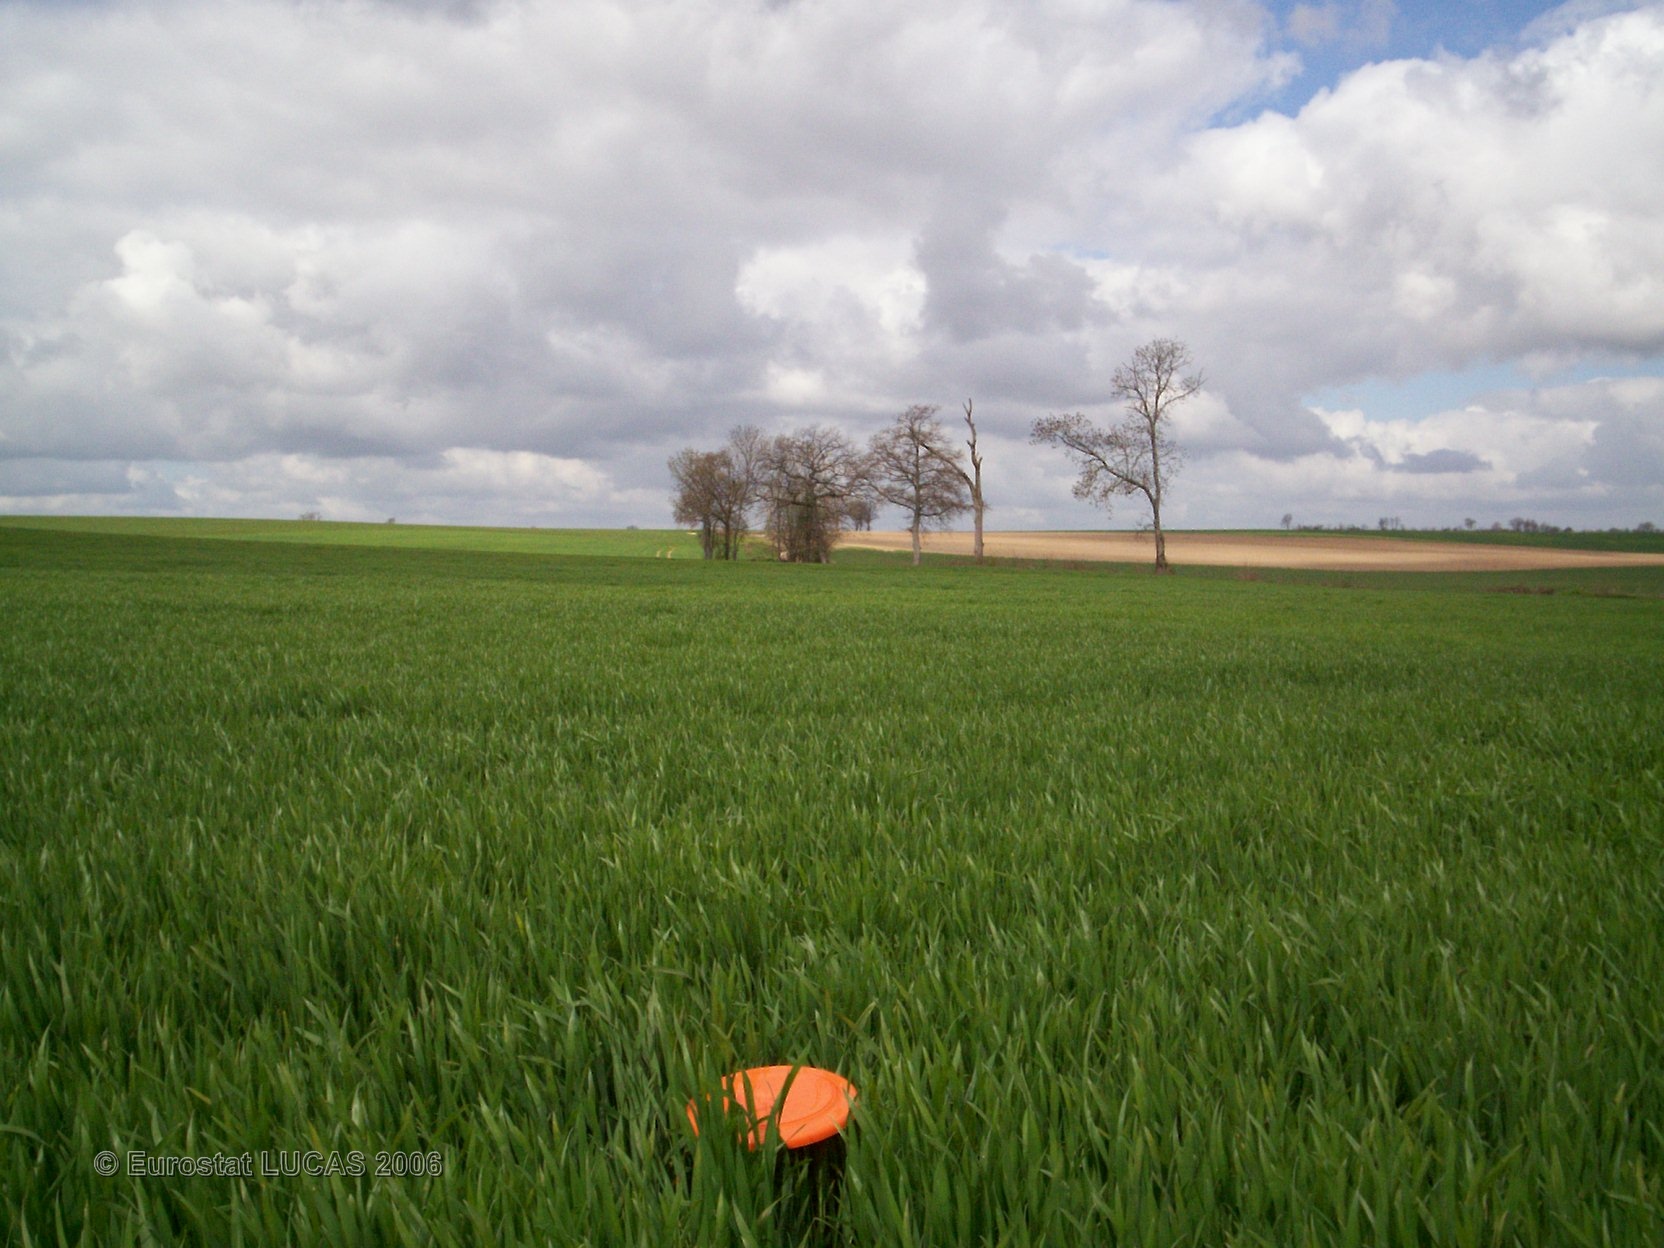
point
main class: Cropland
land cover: Common wheat
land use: Agriculture (excluding fallow land and kitchen gardens)
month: April
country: FR
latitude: 46.4995
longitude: 1.0349
